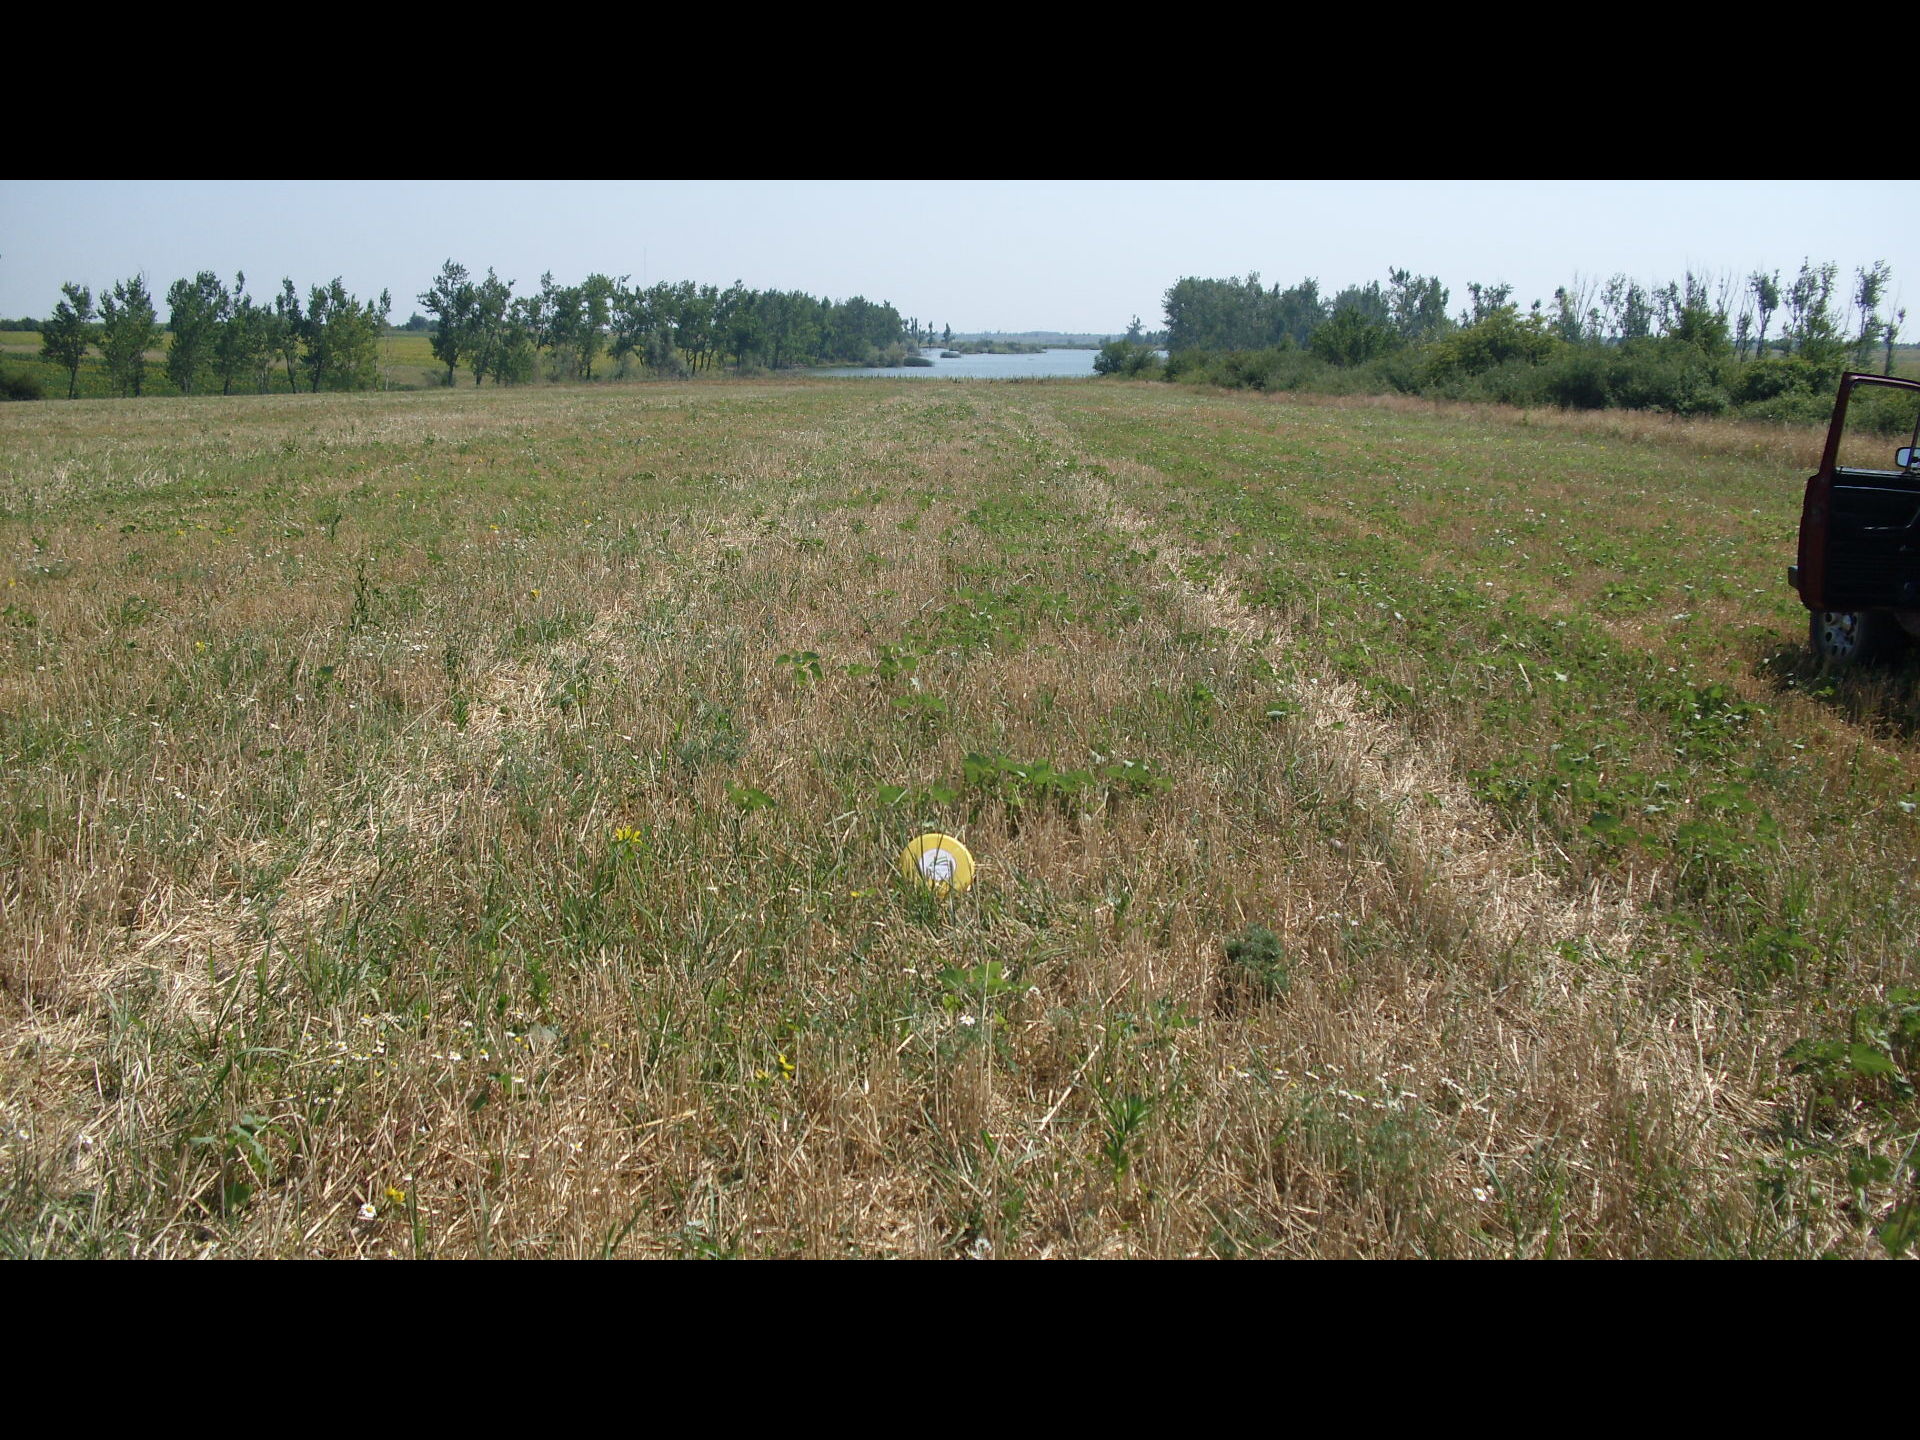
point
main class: Cropland
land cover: Common wheat
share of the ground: 50 - 75 %
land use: Agriculture (excluding fallow land and kitchen gardens)
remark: Harvested field
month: July
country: BG
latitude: 43.8097
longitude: 22.6527
